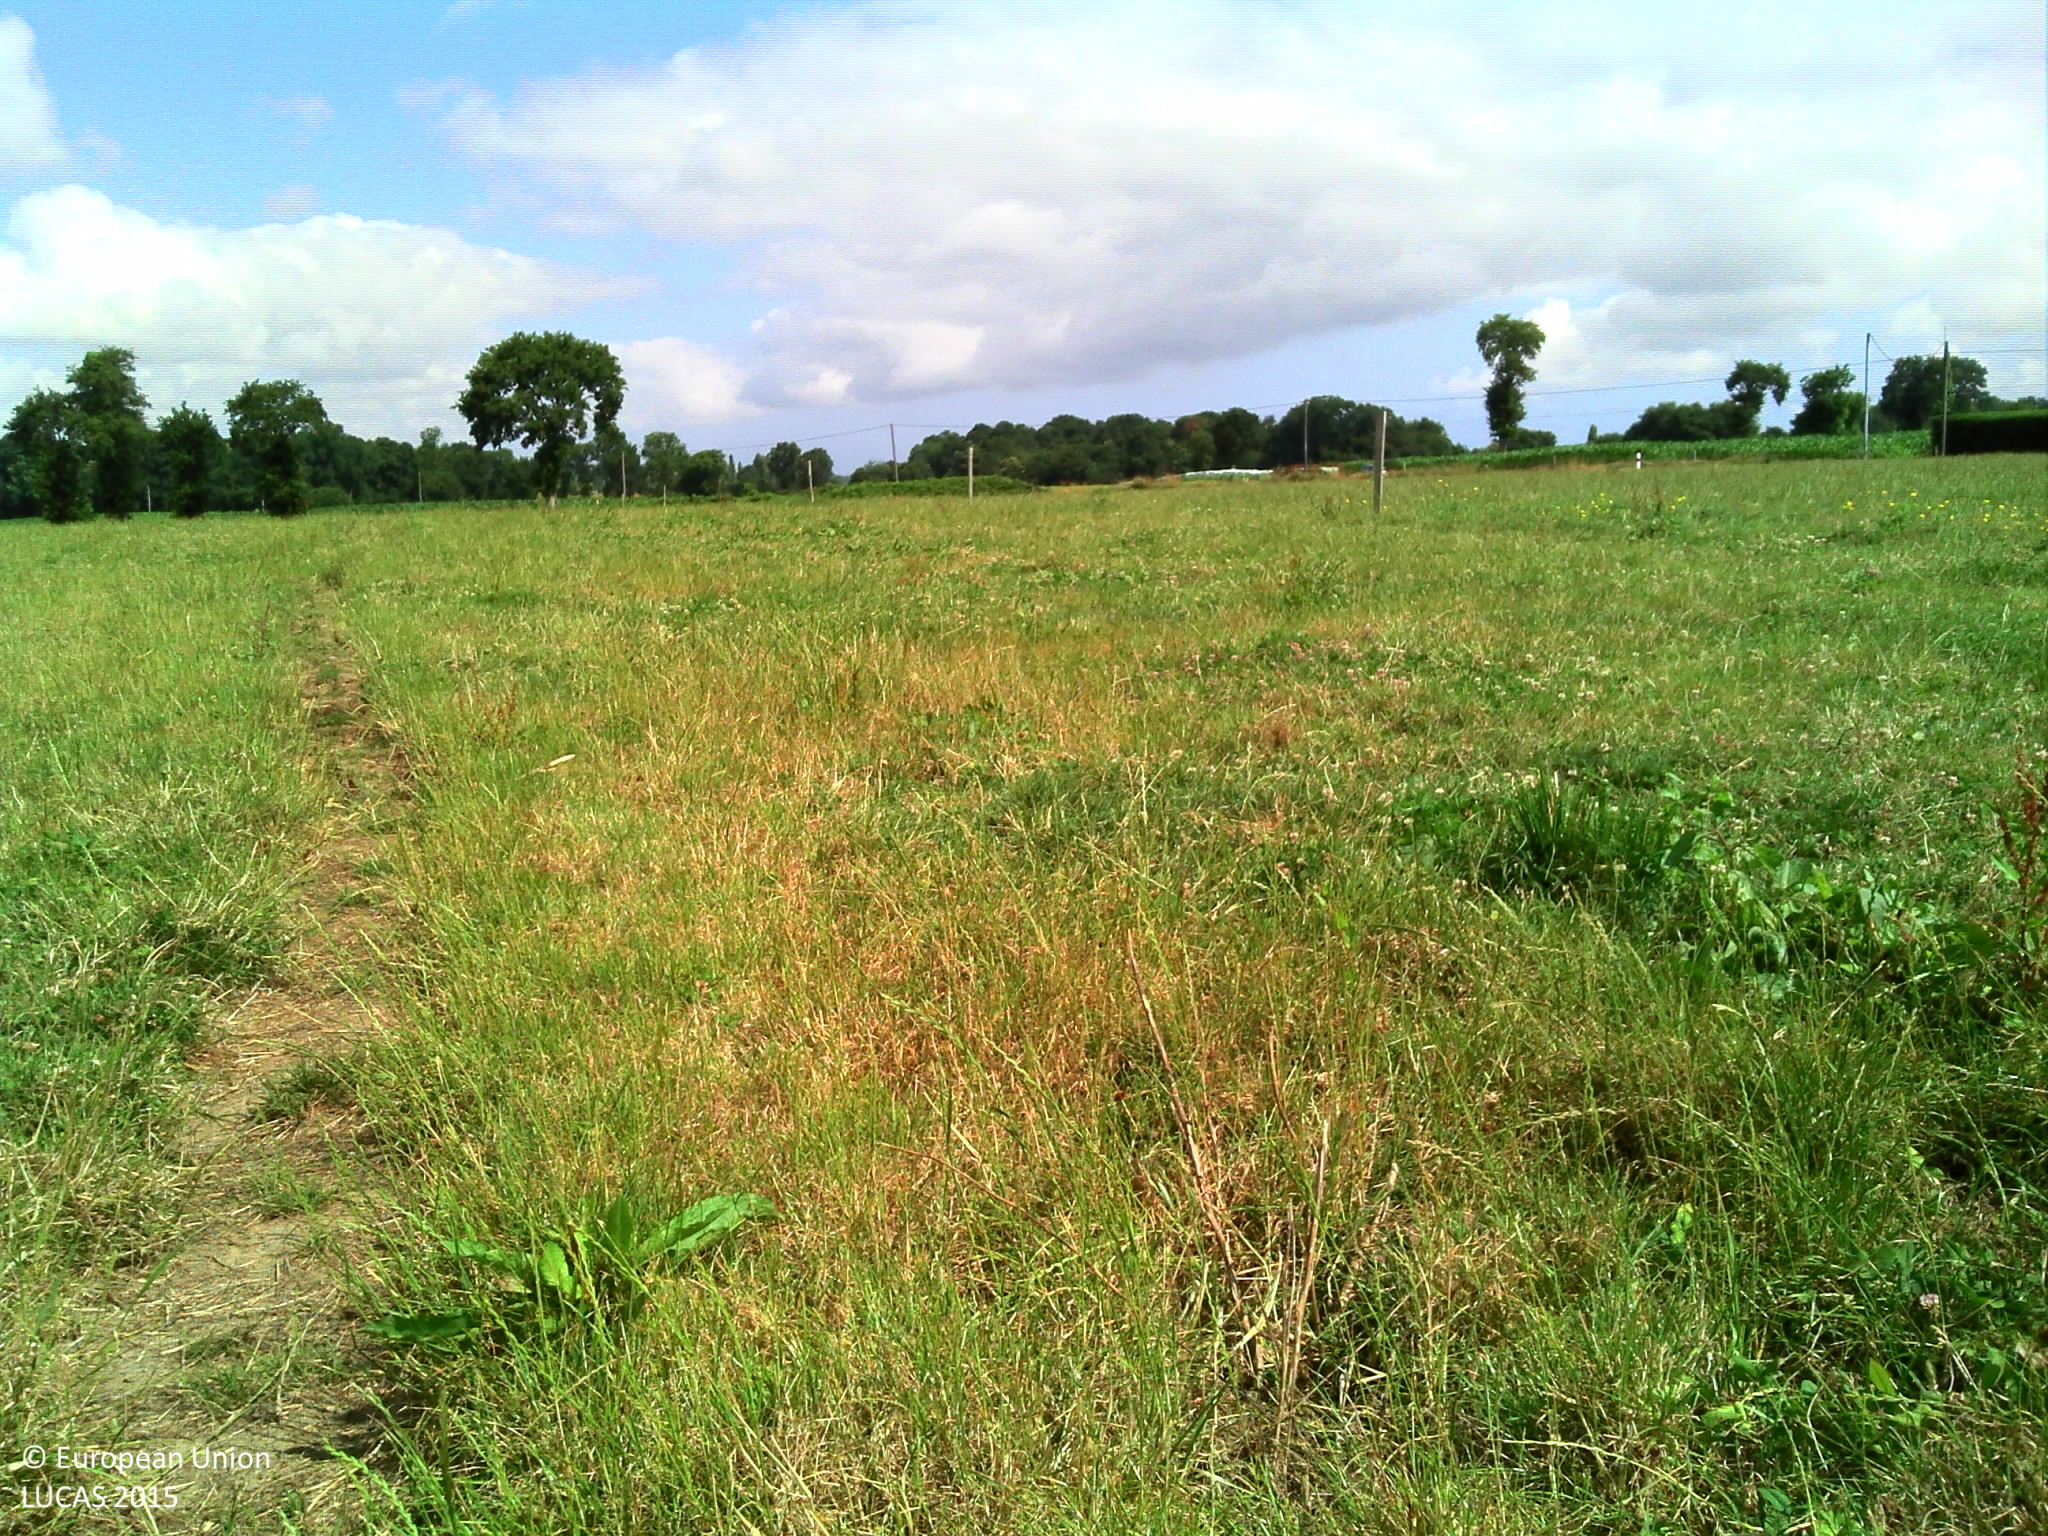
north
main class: Grassland
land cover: Grassland without tree/shrub cover
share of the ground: > 75 %
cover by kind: herbaceous plants 95 %, unconsolidated bare surface 5 %
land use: Agriculture (excluding fallow land and kitchen gardens)
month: July
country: FR
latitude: 48.4691
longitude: -2.2166
